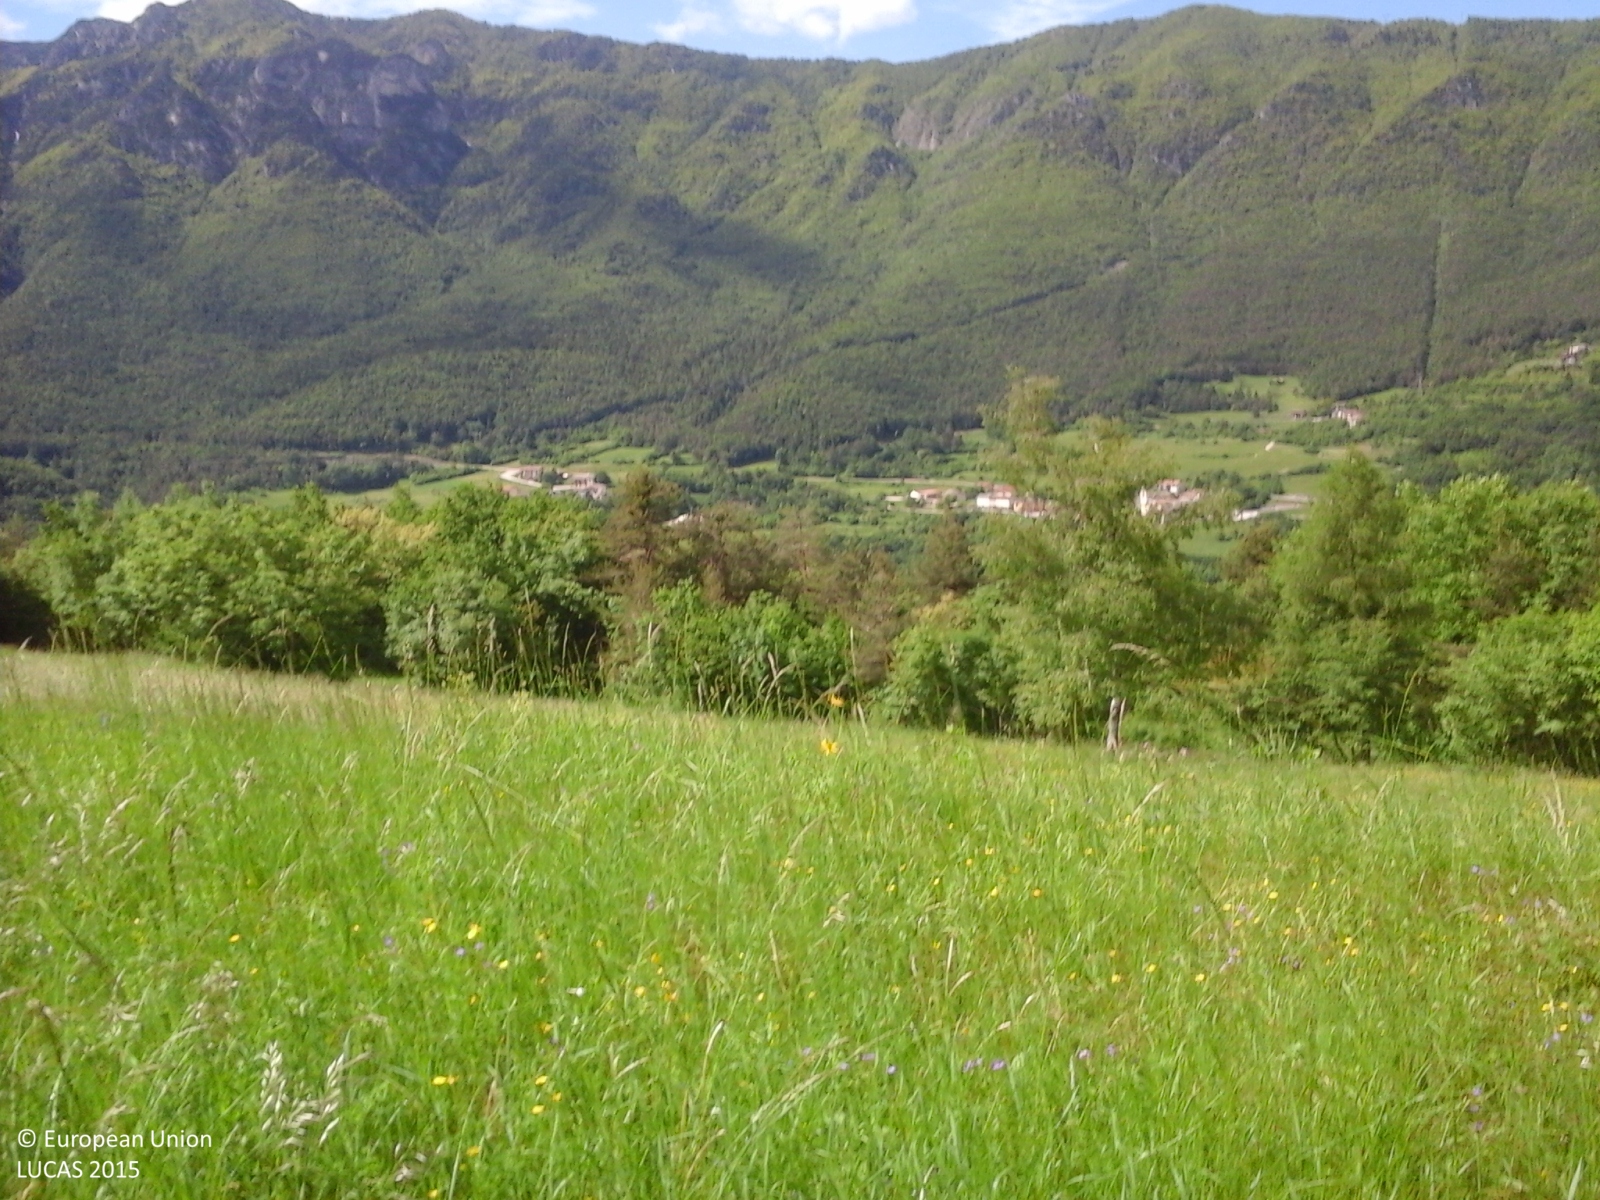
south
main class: Grassland
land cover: Grassland without tree/shrub cover
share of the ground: > 75 %
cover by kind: herbaceous plants 100 %
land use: Agriculture (excluding fallow land and kitchen gardens)
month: May
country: IT
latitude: 45.7868
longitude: 11.1174
